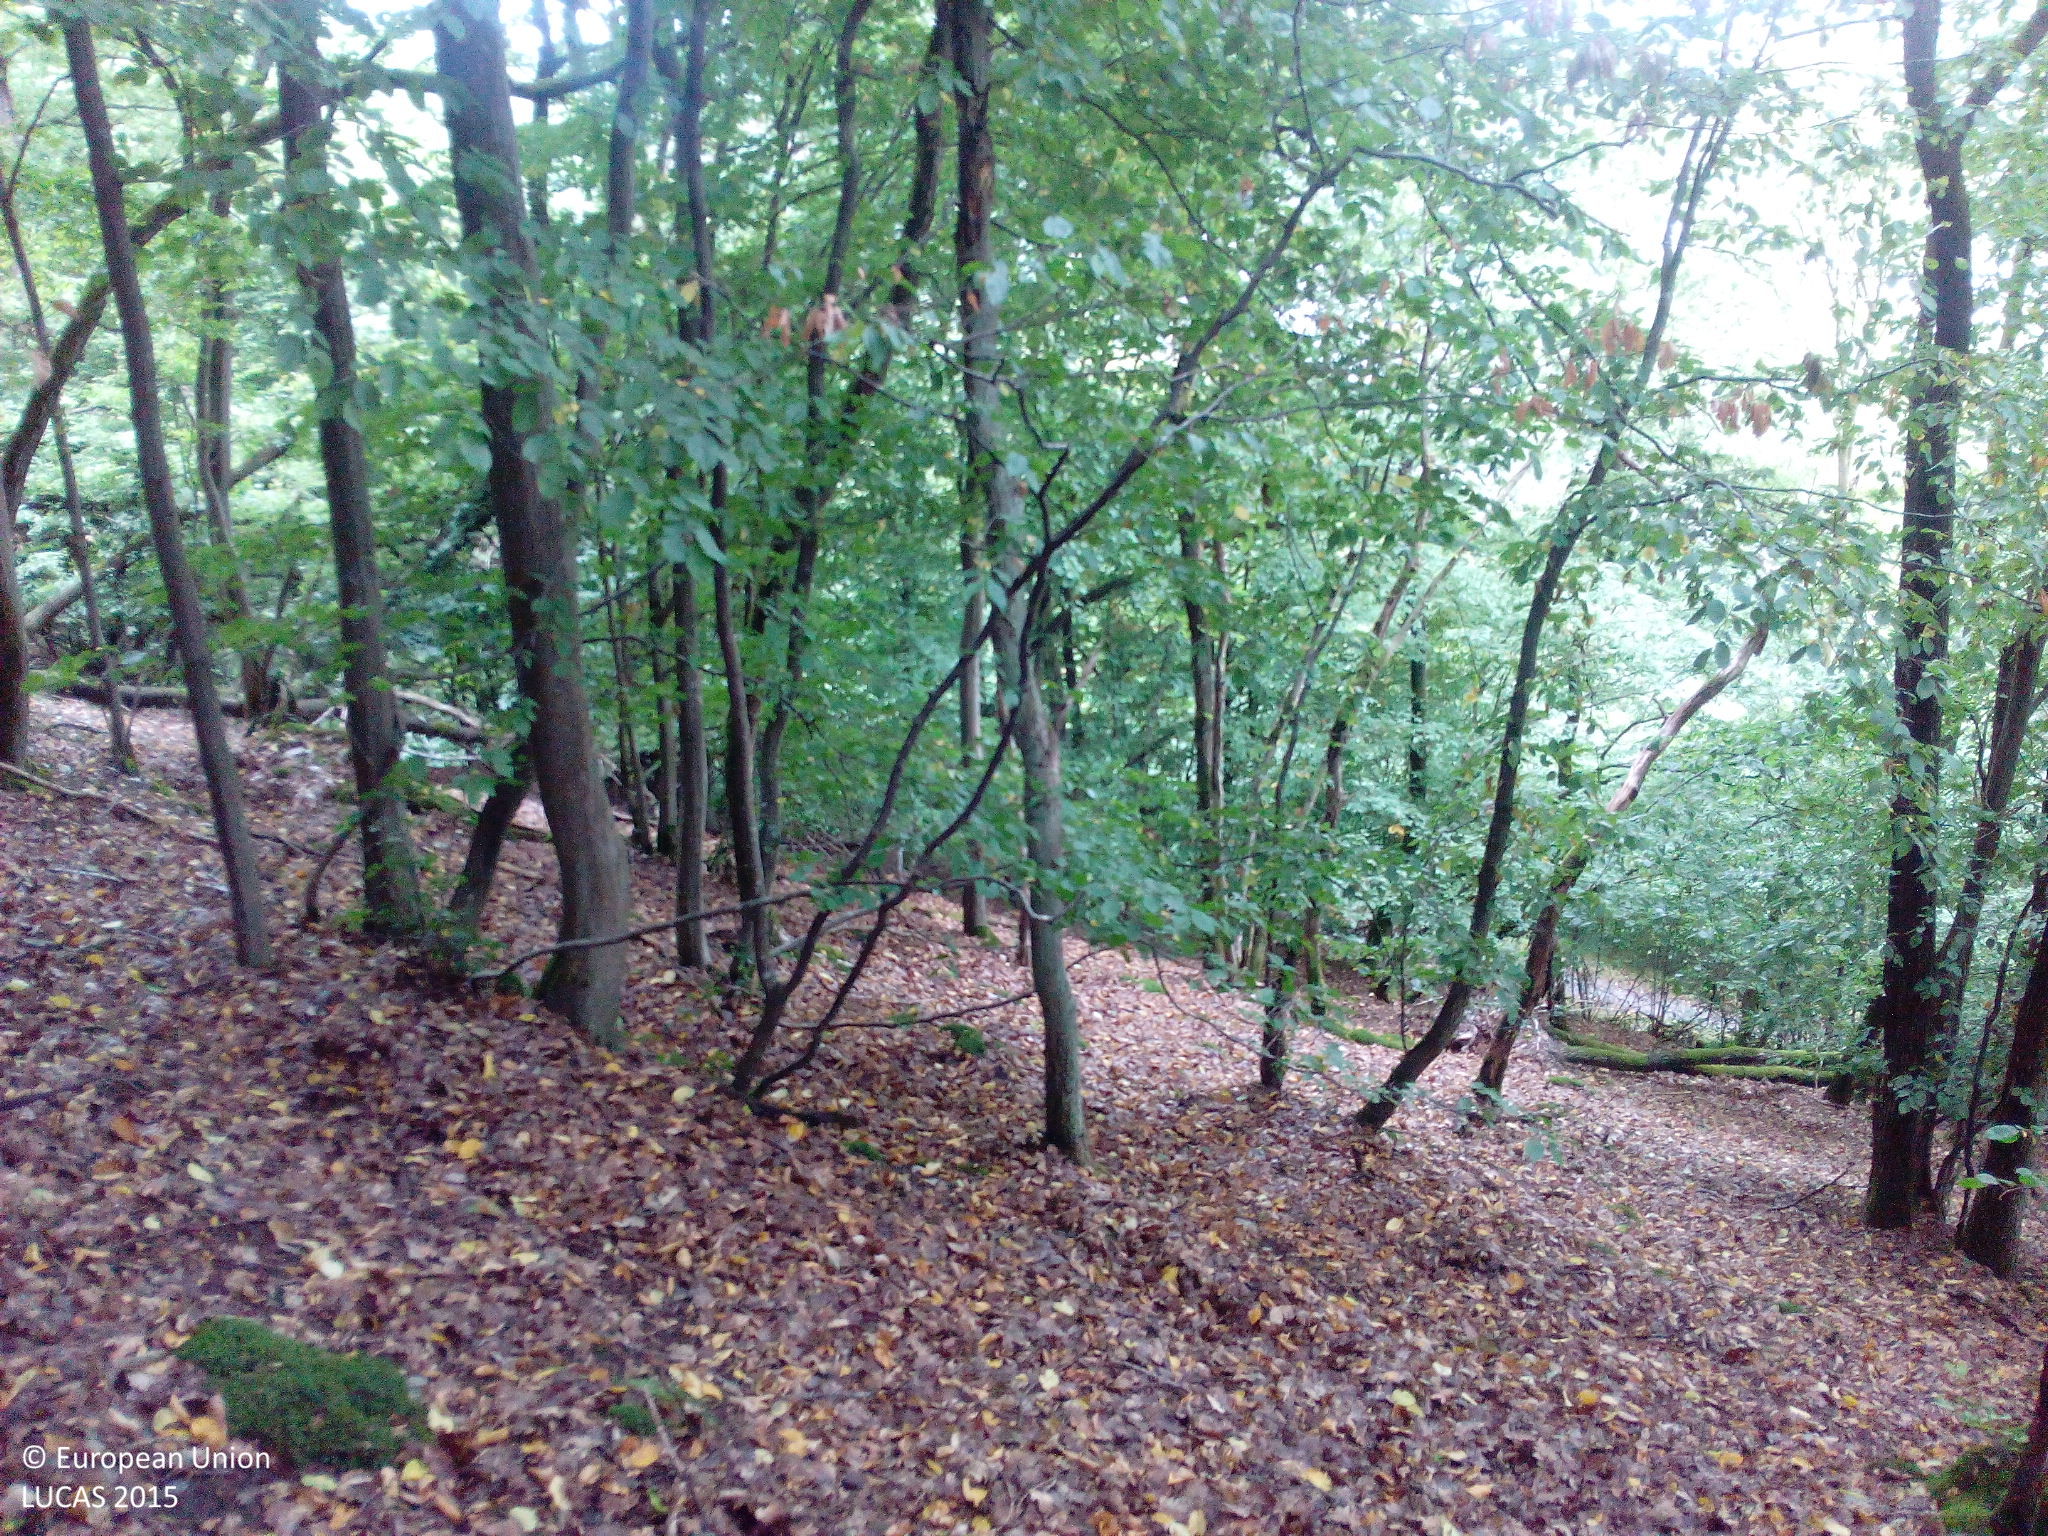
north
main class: Woodland
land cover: Broadleaved woodland
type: mesophytic deciduous forest
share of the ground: > 75 %
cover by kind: broadleaved forest trees 100 %
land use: Forestry
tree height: > 5 m
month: July
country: DE
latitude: 49.9858
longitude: 7.1131
